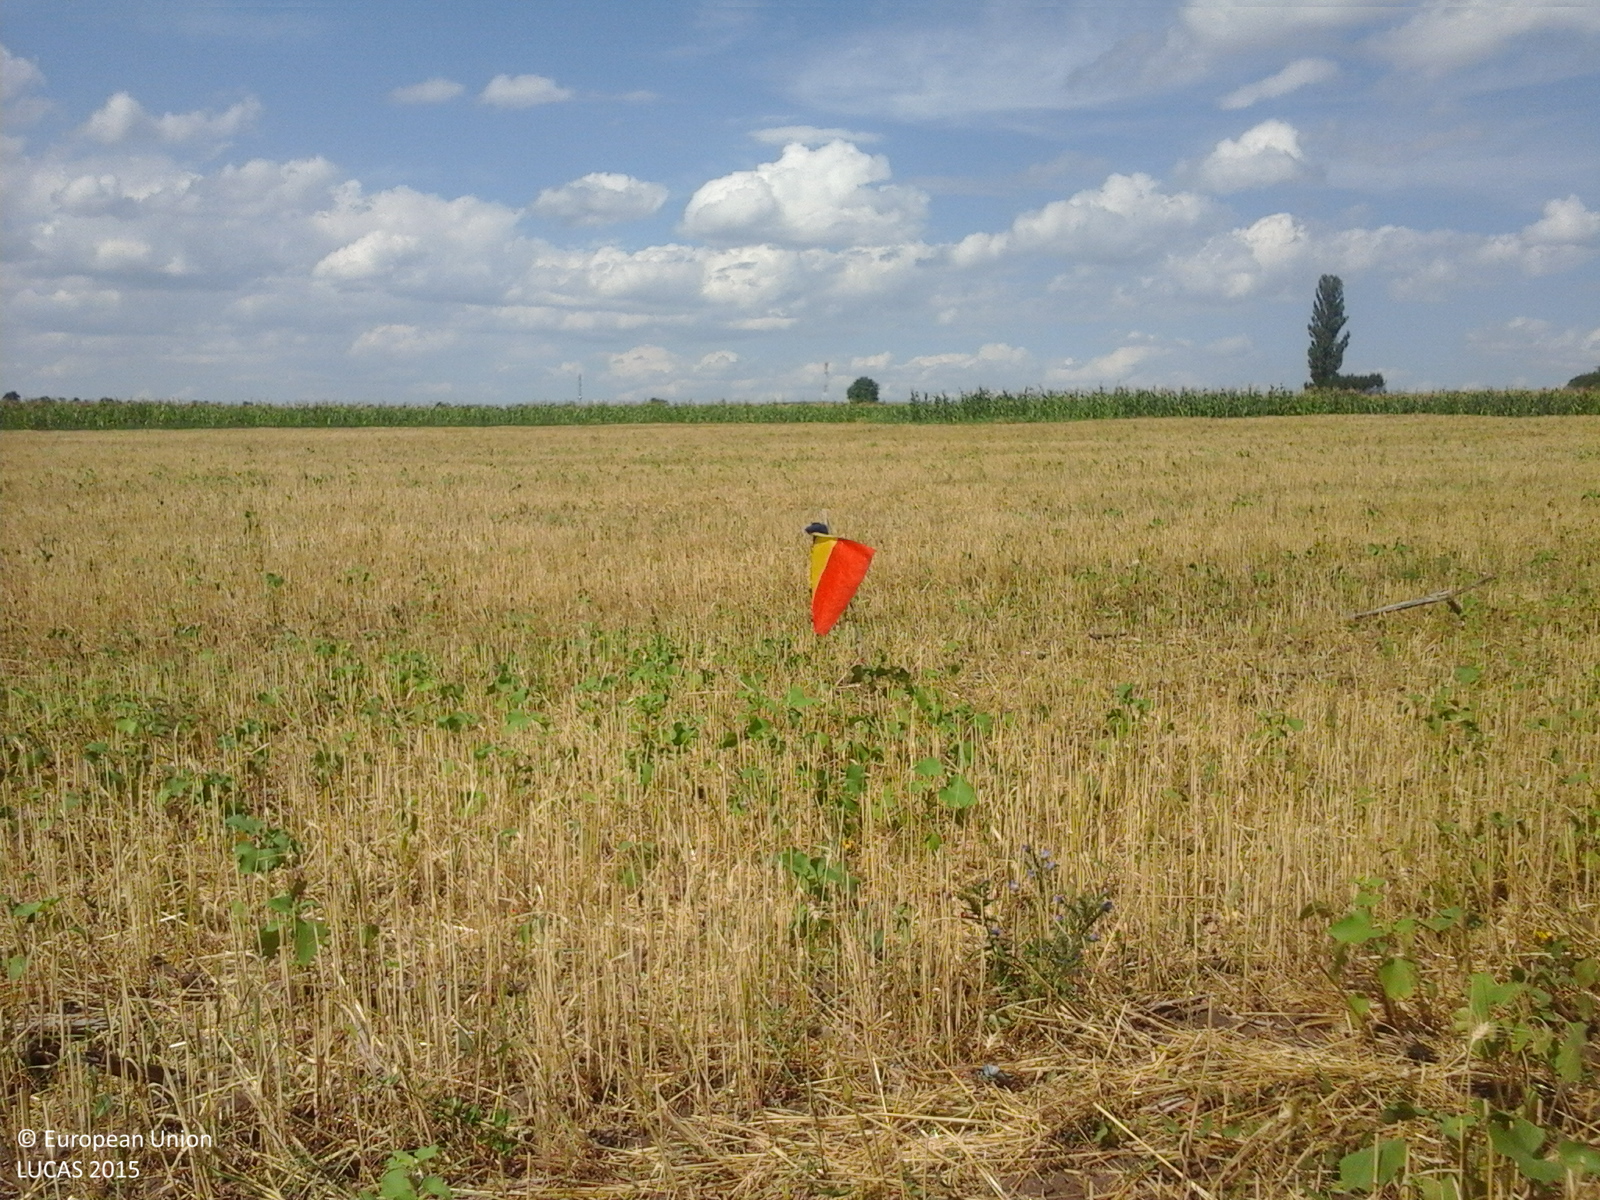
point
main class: Cropland
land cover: Common wheat
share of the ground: 10 - 25 %
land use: Agriculture (excluding fallow land and kitchen gardens)
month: July
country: RO
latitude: 46.4658
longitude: 27.7904
